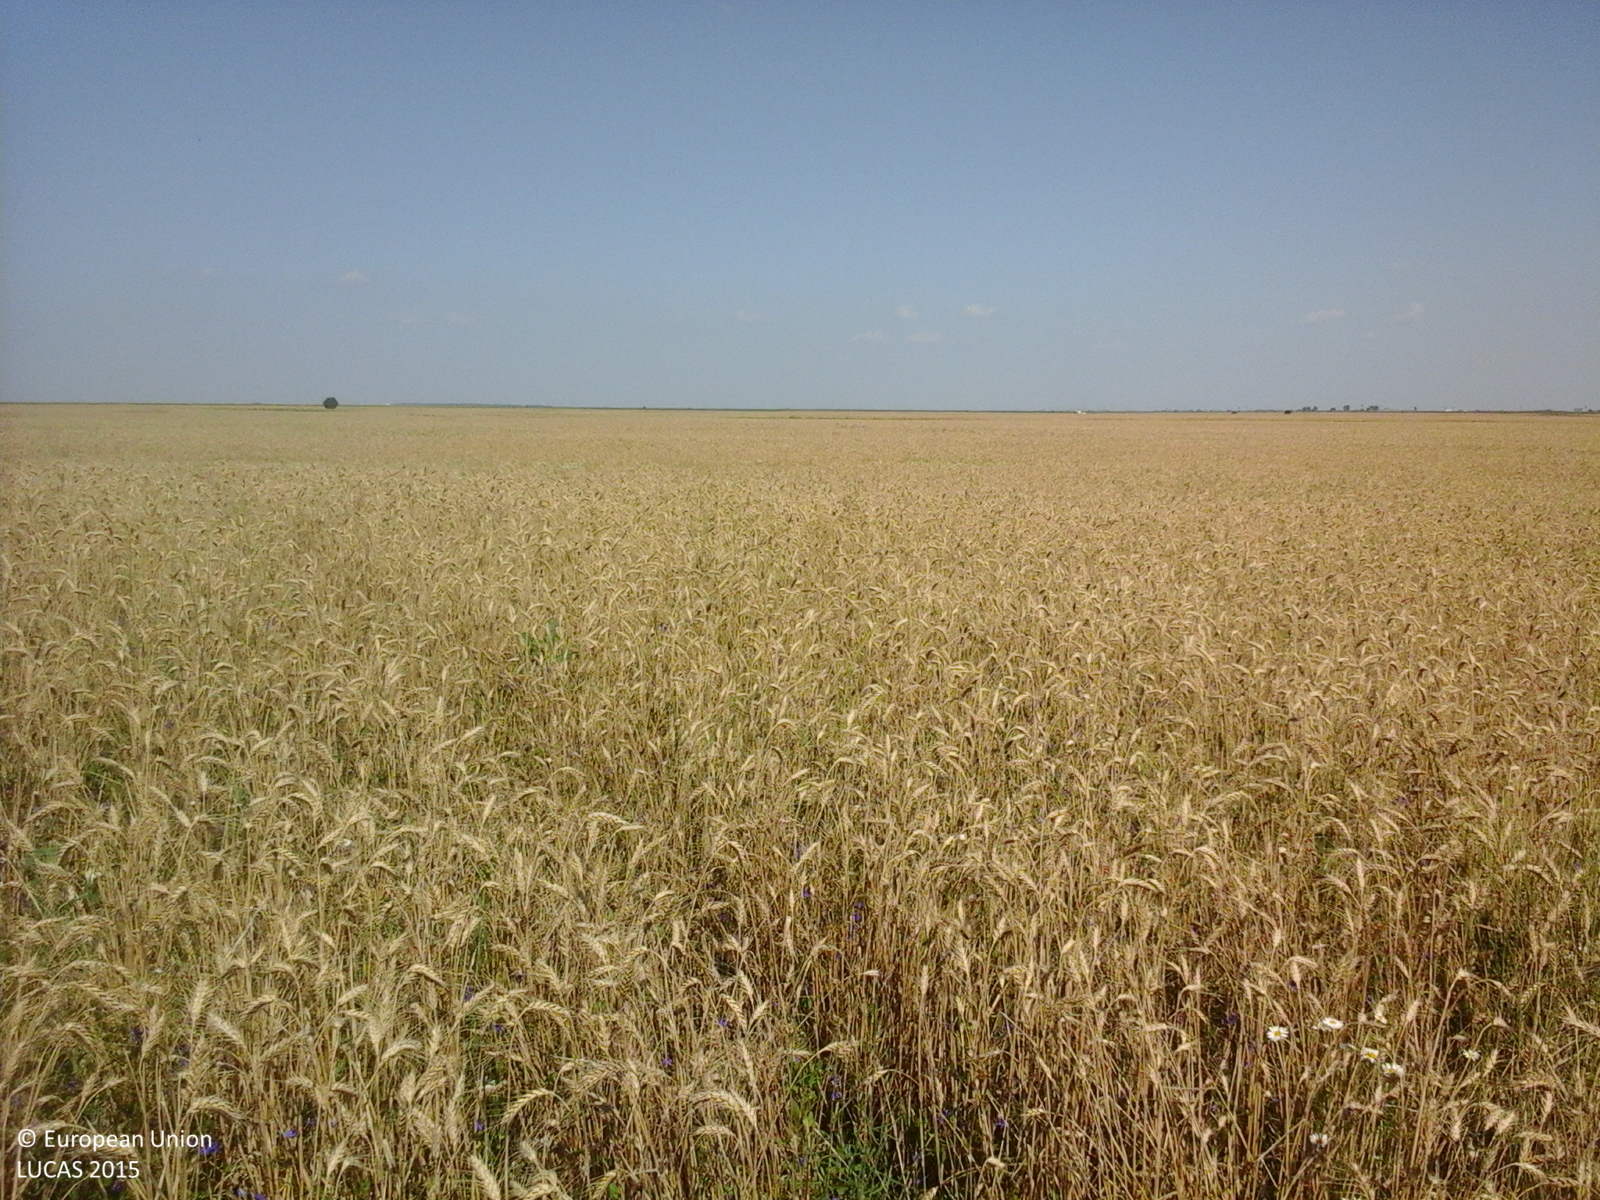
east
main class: Cropland
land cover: Common wheat
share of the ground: > 75 %
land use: Agriculture (excluding fallow land and kitchen gardens)
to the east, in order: Common wheat; Spontaneously vegetated surfaces
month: July
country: RO
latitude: 44.2118
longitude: 24.5754
